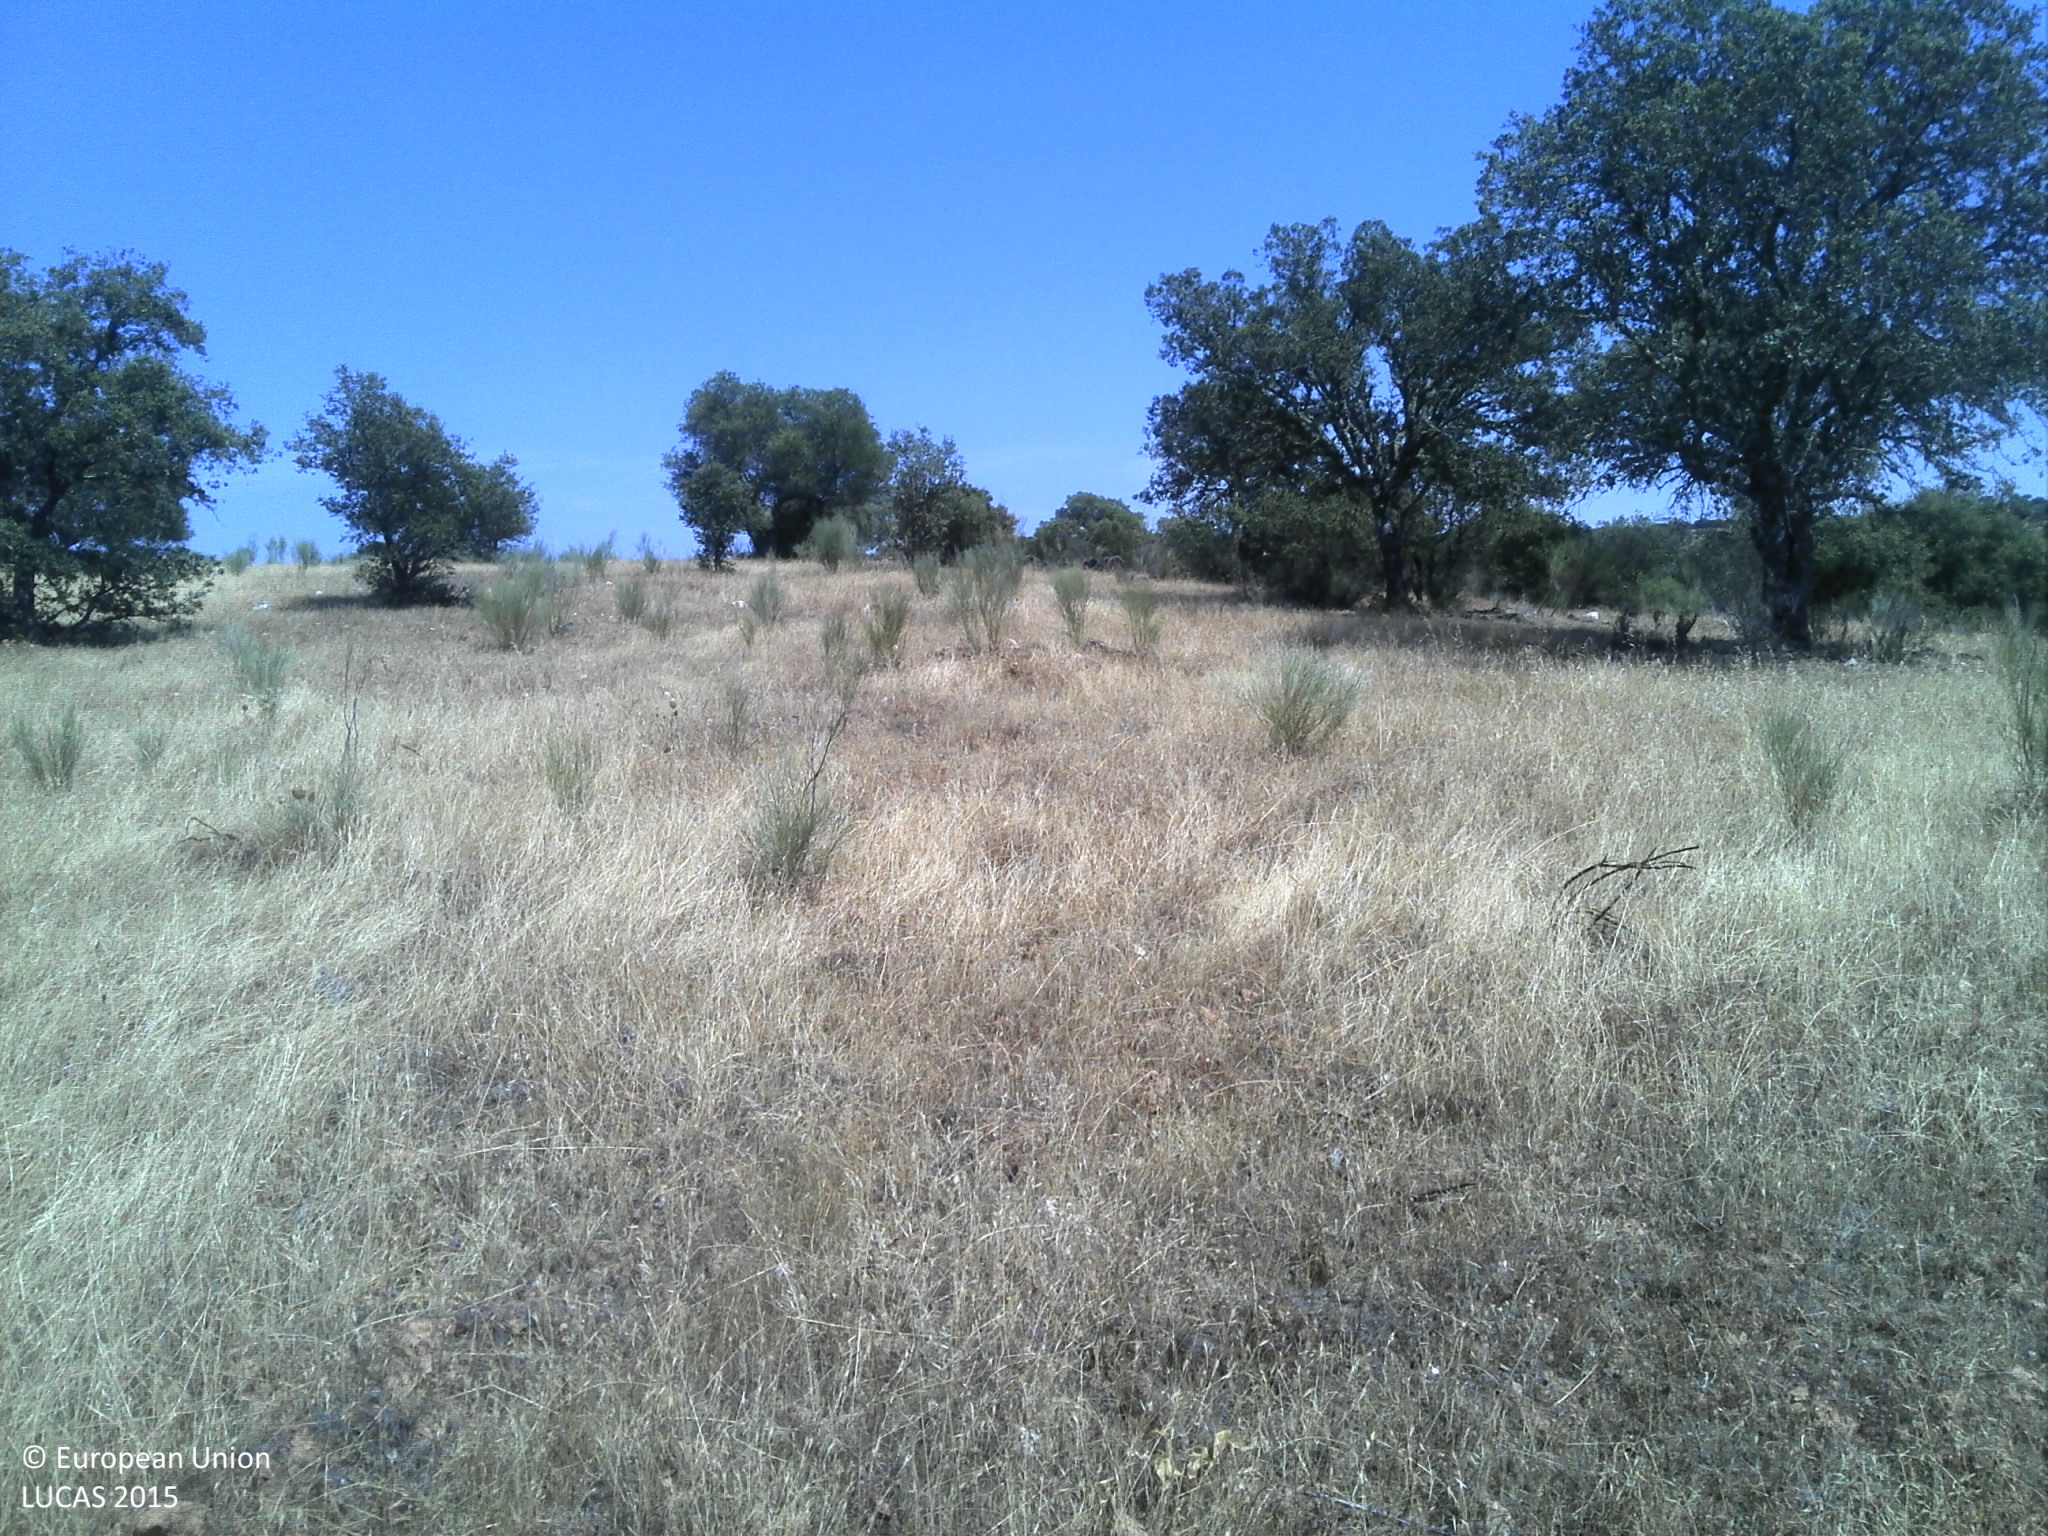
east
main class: Woodland
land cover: Broadleaved woodland
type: broadleaved evergreen forest
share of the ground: 25 - 50 %
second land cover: Grassland without tree/shrub cover
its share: 25 - 50 %
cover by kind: broadleaved forest trees 35 %, herbaceous plants 35 %, unconsolidated bare surface 20 %, shrubs 5 %
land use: Forestry
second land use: Agriculture (excluding fallow land and kitchen gardens)
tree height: > 5 m
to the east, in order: Broadleaved woodland; Grassland without tree/shrub cover; Broadleaved woodland; Grassland with sparse tree/shrub cover; Tracks; Grassland with sparse tree/shrub cover
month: June
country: PT
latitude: 39.7954
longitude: -7.1527
